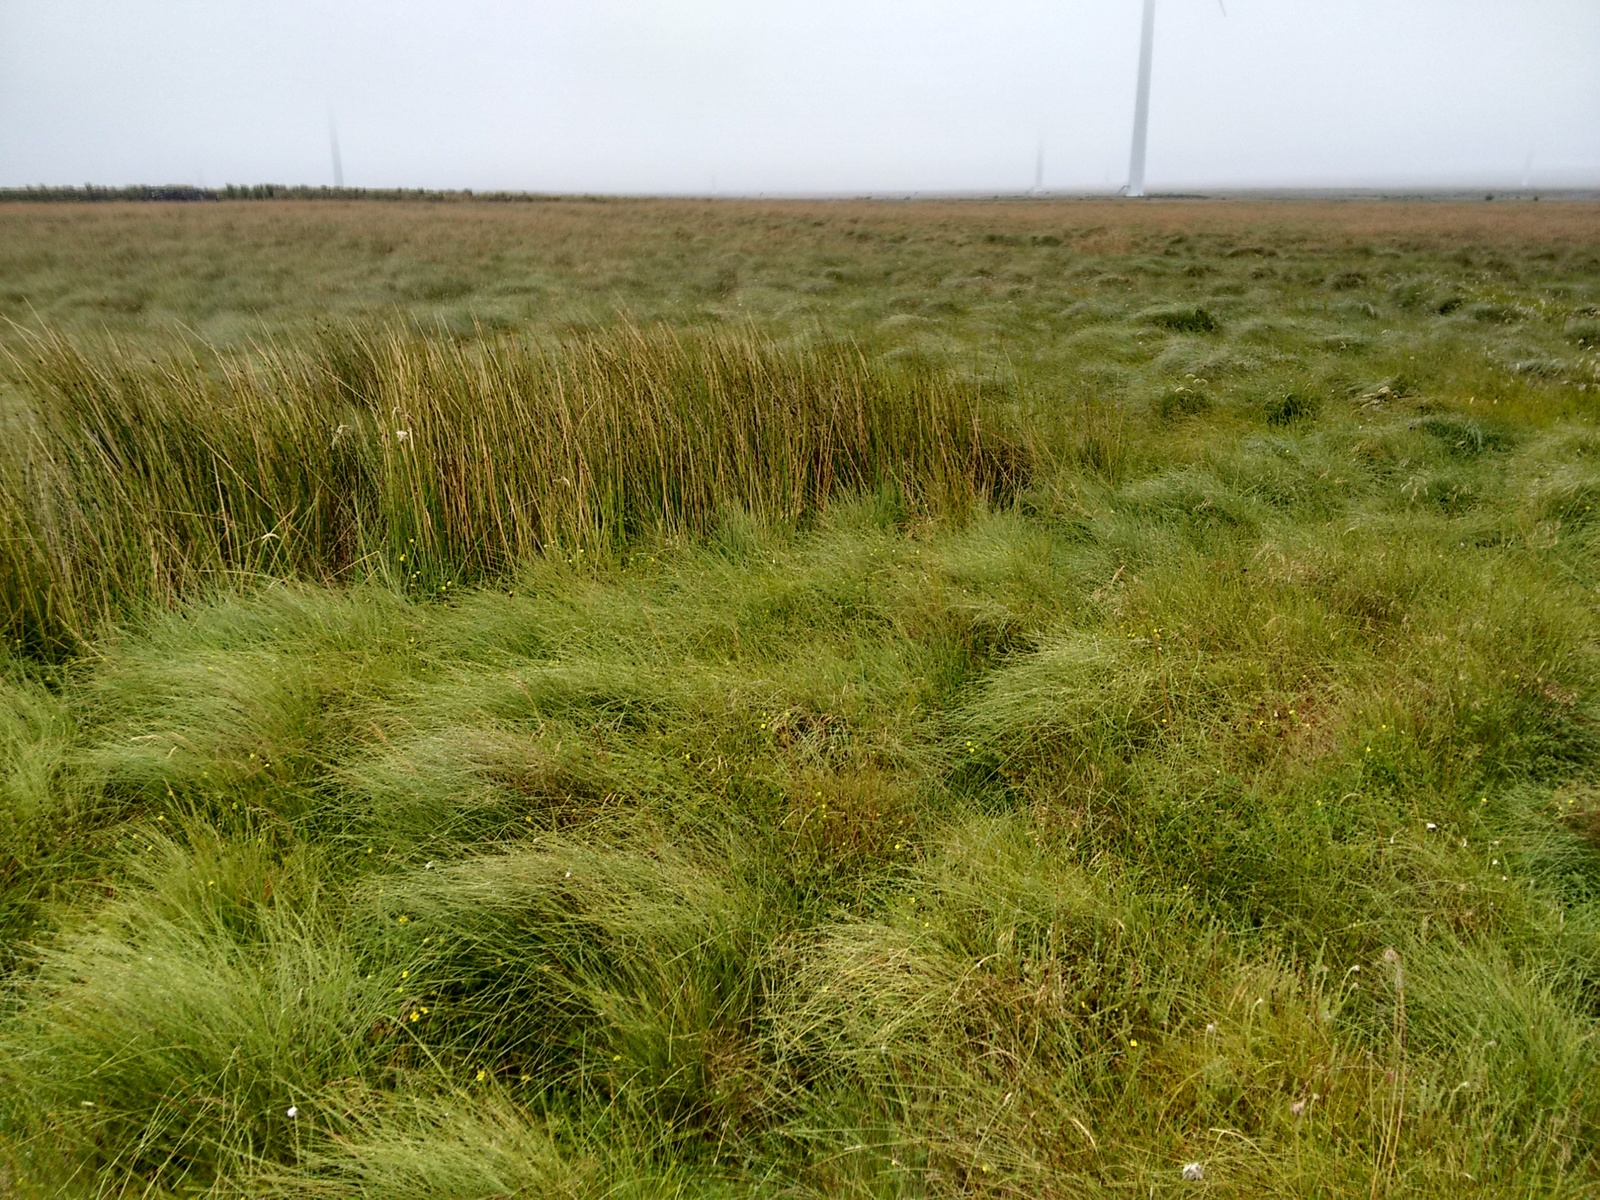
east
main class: Grassland
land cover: Grassland without tree/shrub cover
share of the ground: > 75 %
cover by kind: herbaceous plants 100 %
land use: Energy production
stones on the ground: < 10 %
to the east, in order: Grassland without tree/shrub cover; Tracks; Grassland without tree/shrub cover
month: August
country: GB
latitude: 58.4141
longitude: -3.2931
